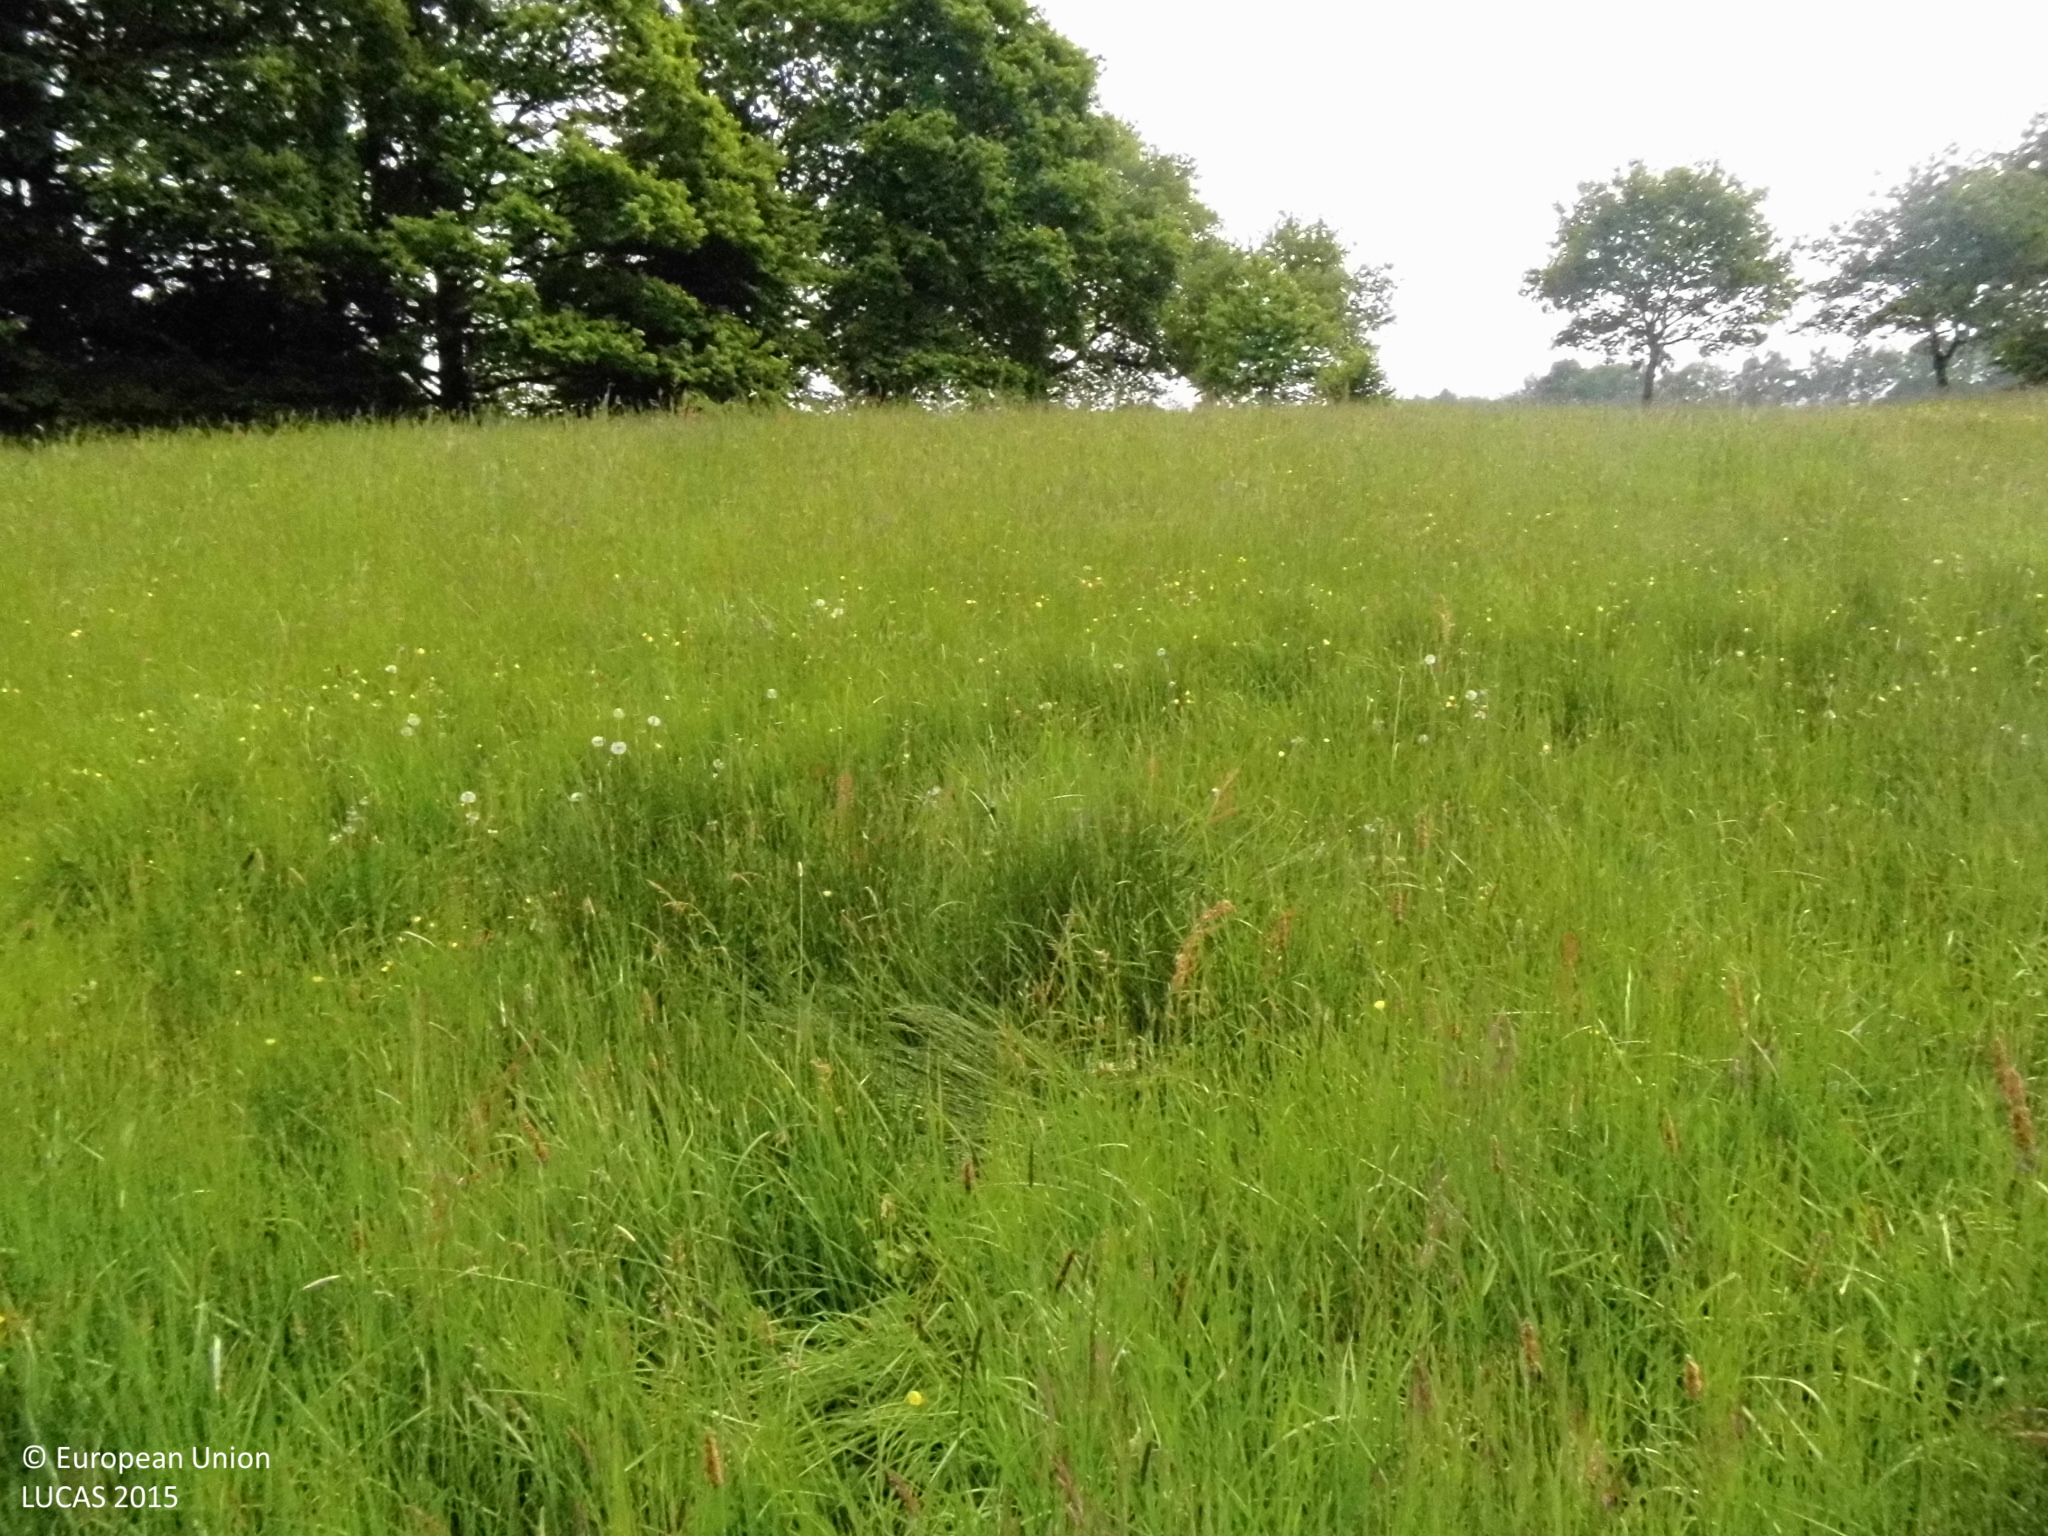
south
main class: Grassland
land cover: Grassland without tree/shrub cover
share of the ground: > 75 %
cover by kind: herbaceous plants 100 %
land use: Agriculture (excluding fallow land and kitchen gardens)
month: May
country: DE
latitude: 50.7131
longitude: 7.4368
